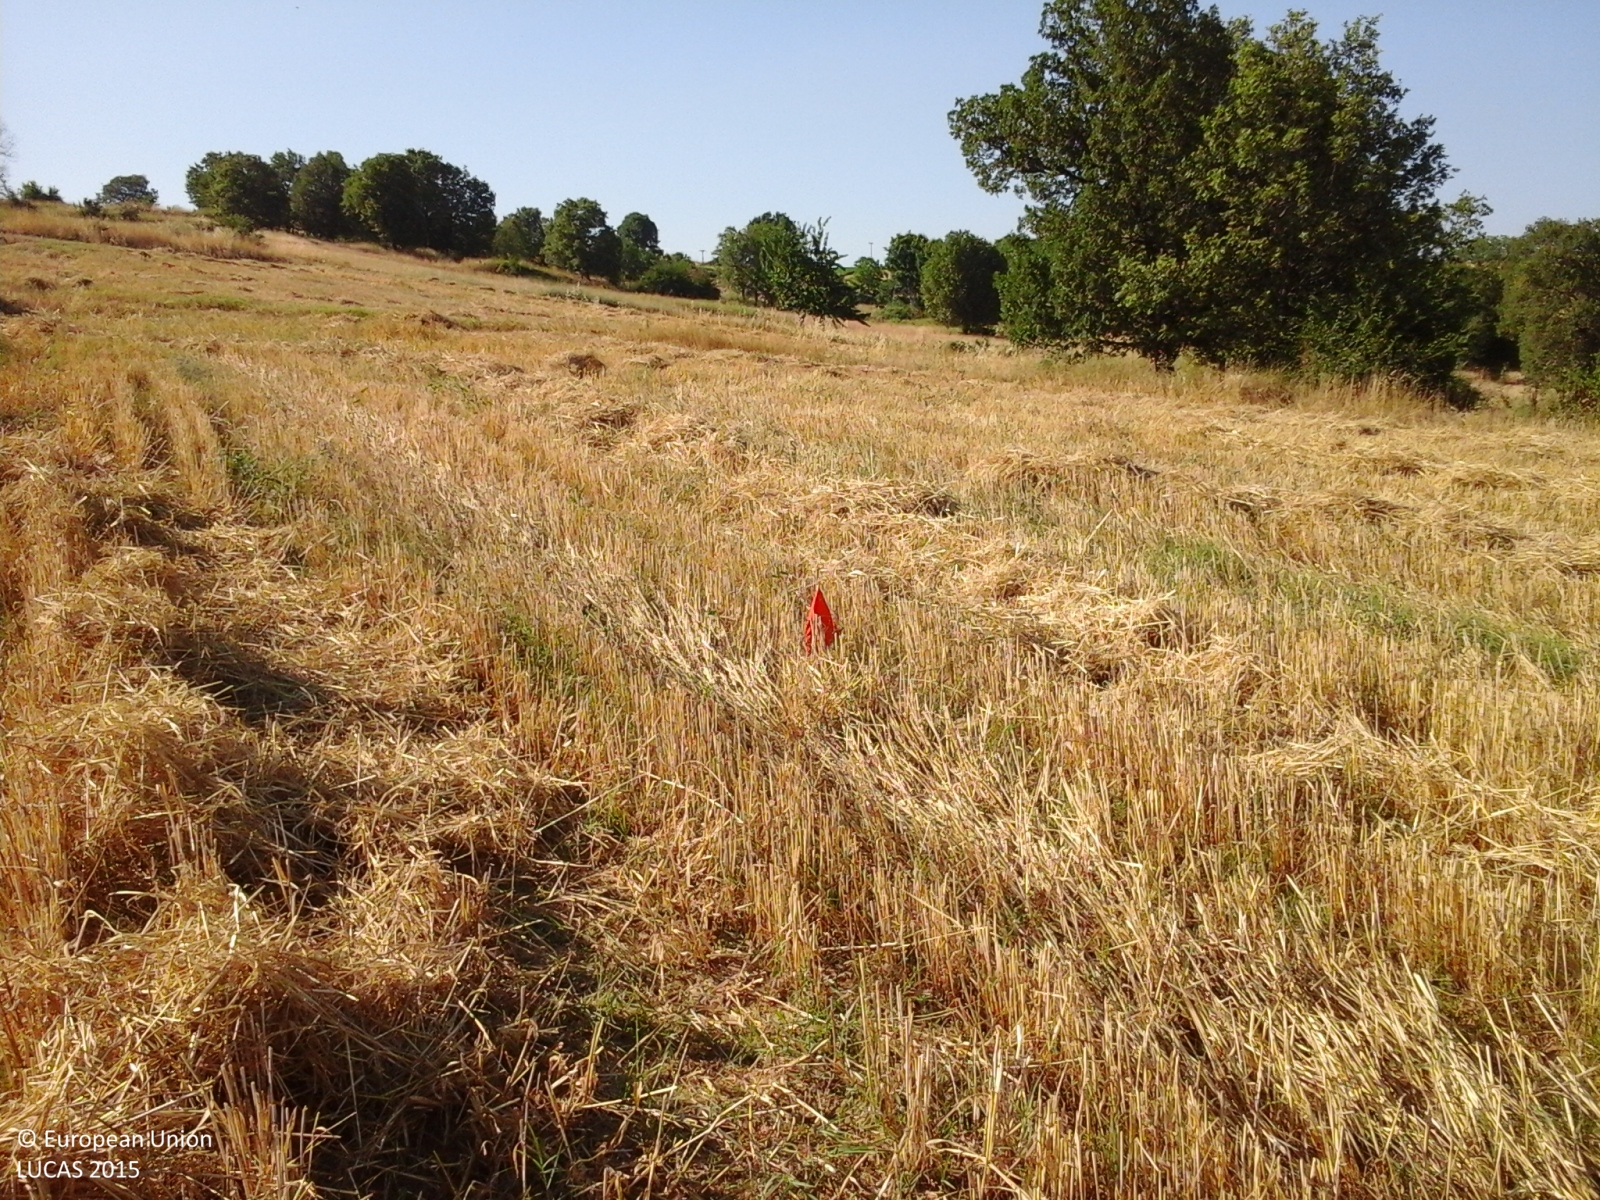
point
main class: Cropland
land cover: Barley
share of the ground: > 75 %
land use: Agriculture (excluding fallow land and kitchen gardens)
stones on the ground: < 10 %
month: July
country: GR
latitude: 40.3215
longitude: 21.3216
